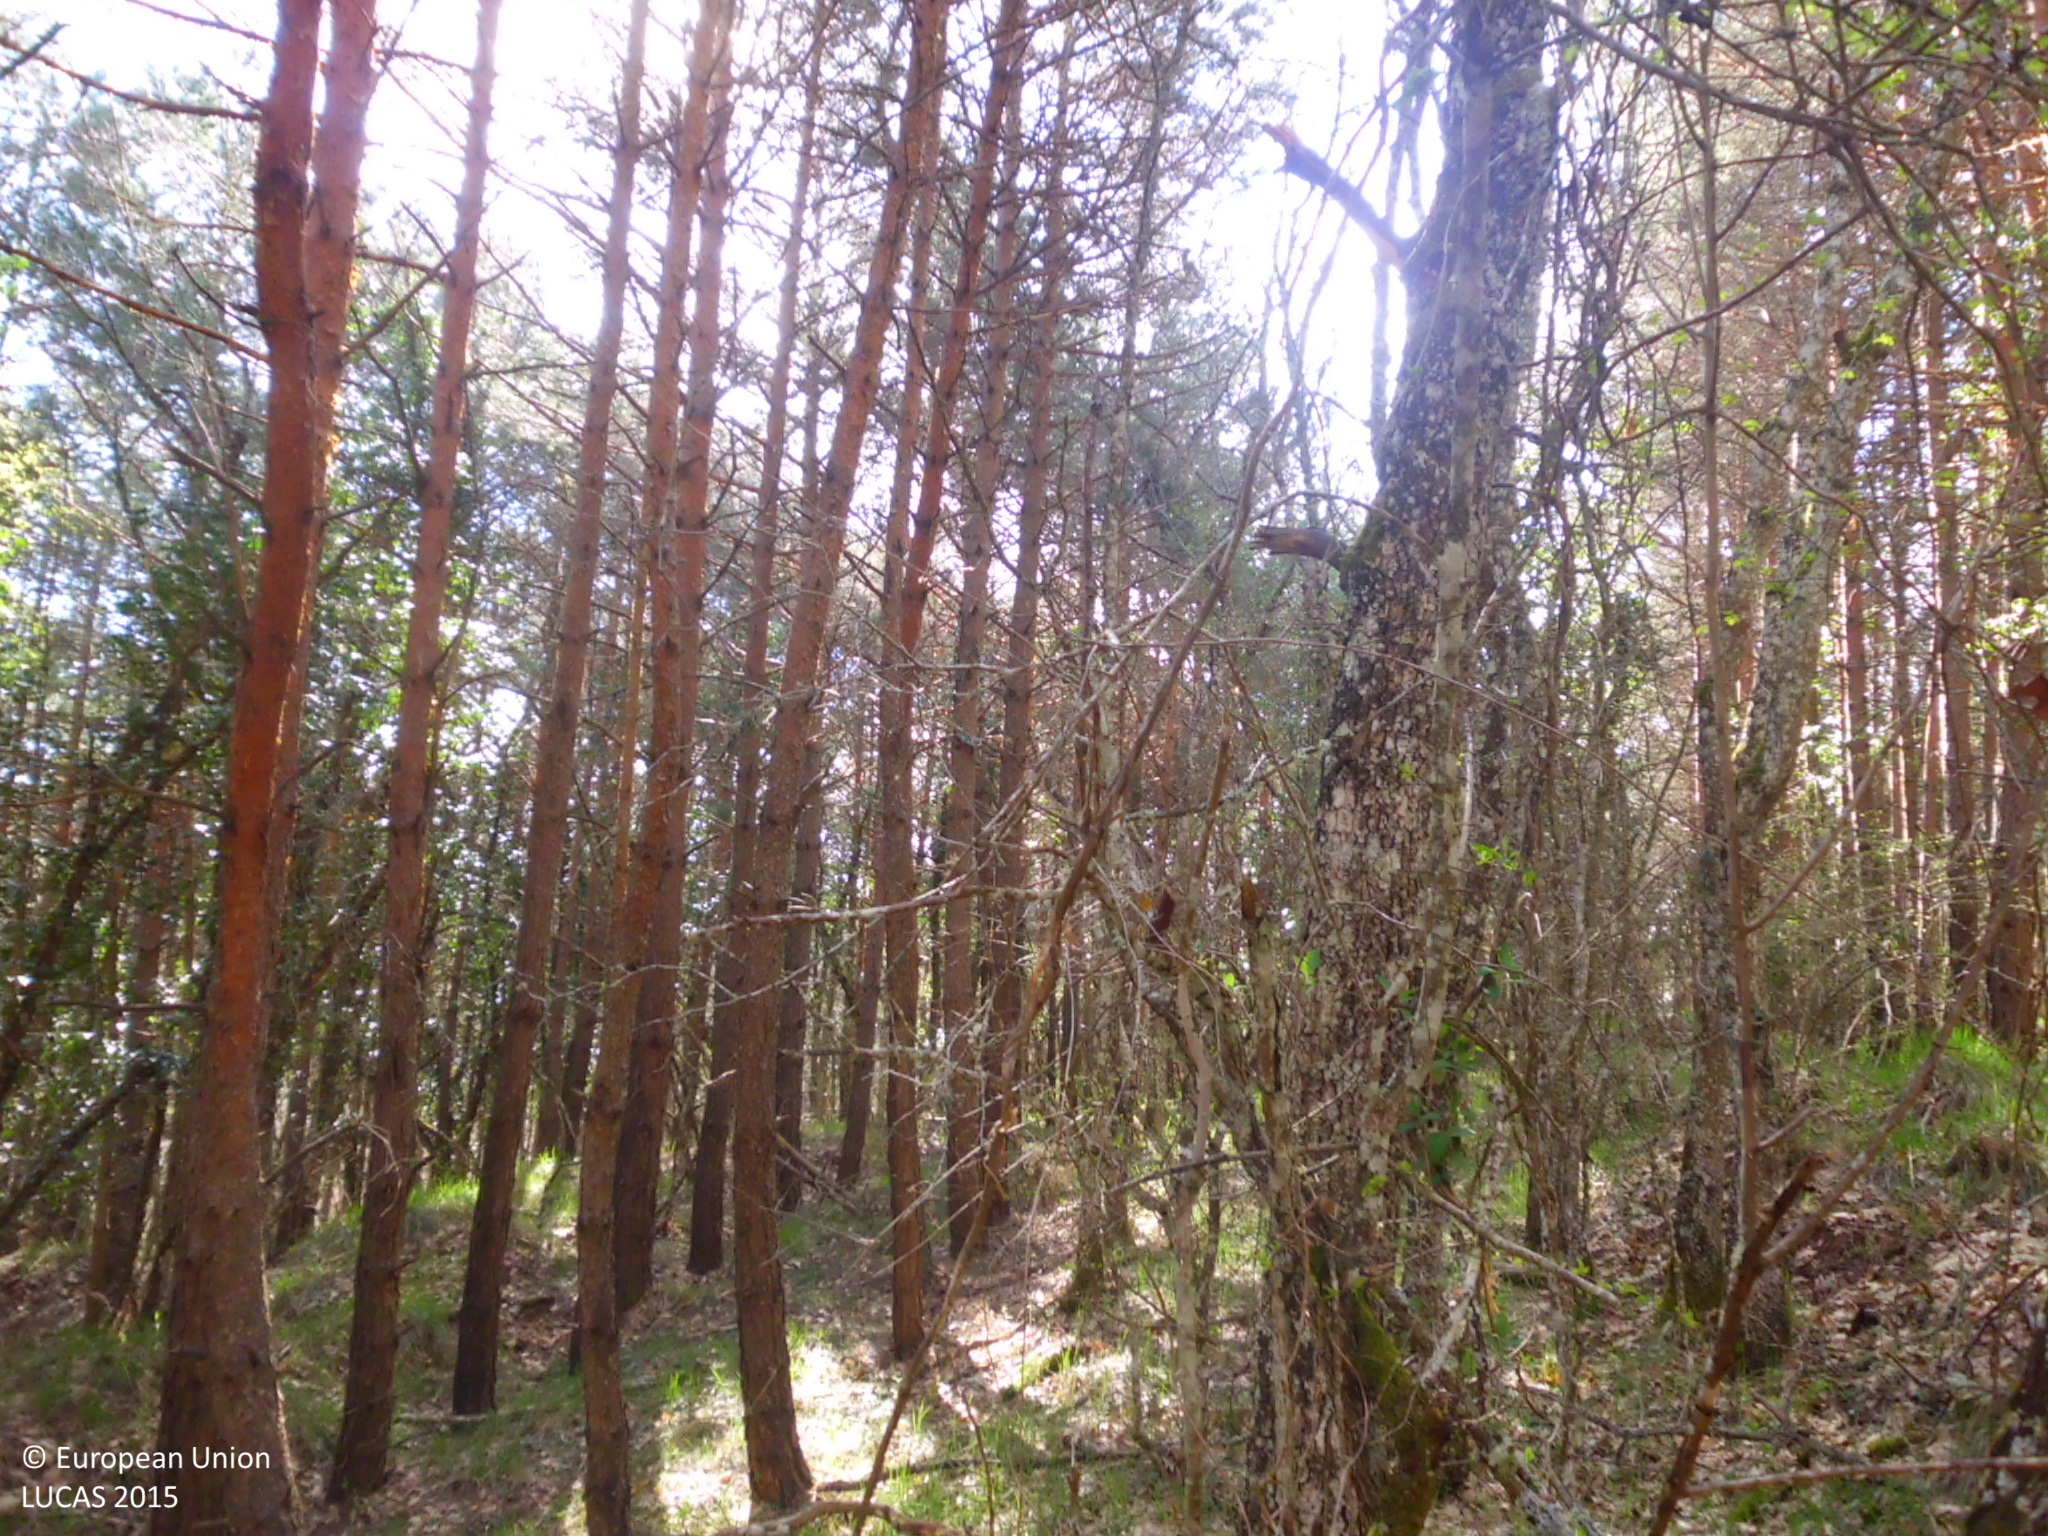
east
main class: Woodland
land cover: Pine dominated coniferous woodland
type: coniferous forest of the mediterranean region
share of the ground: > 75 %
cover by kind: coniferous forest trees 100 %
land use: Forestry
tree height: > 5 m
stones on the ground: < 10 %
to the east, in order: Pine dominated coniferous woodland; Broadleaved woodland
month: April
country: ES
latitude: 42.3801
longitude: -3.4043
